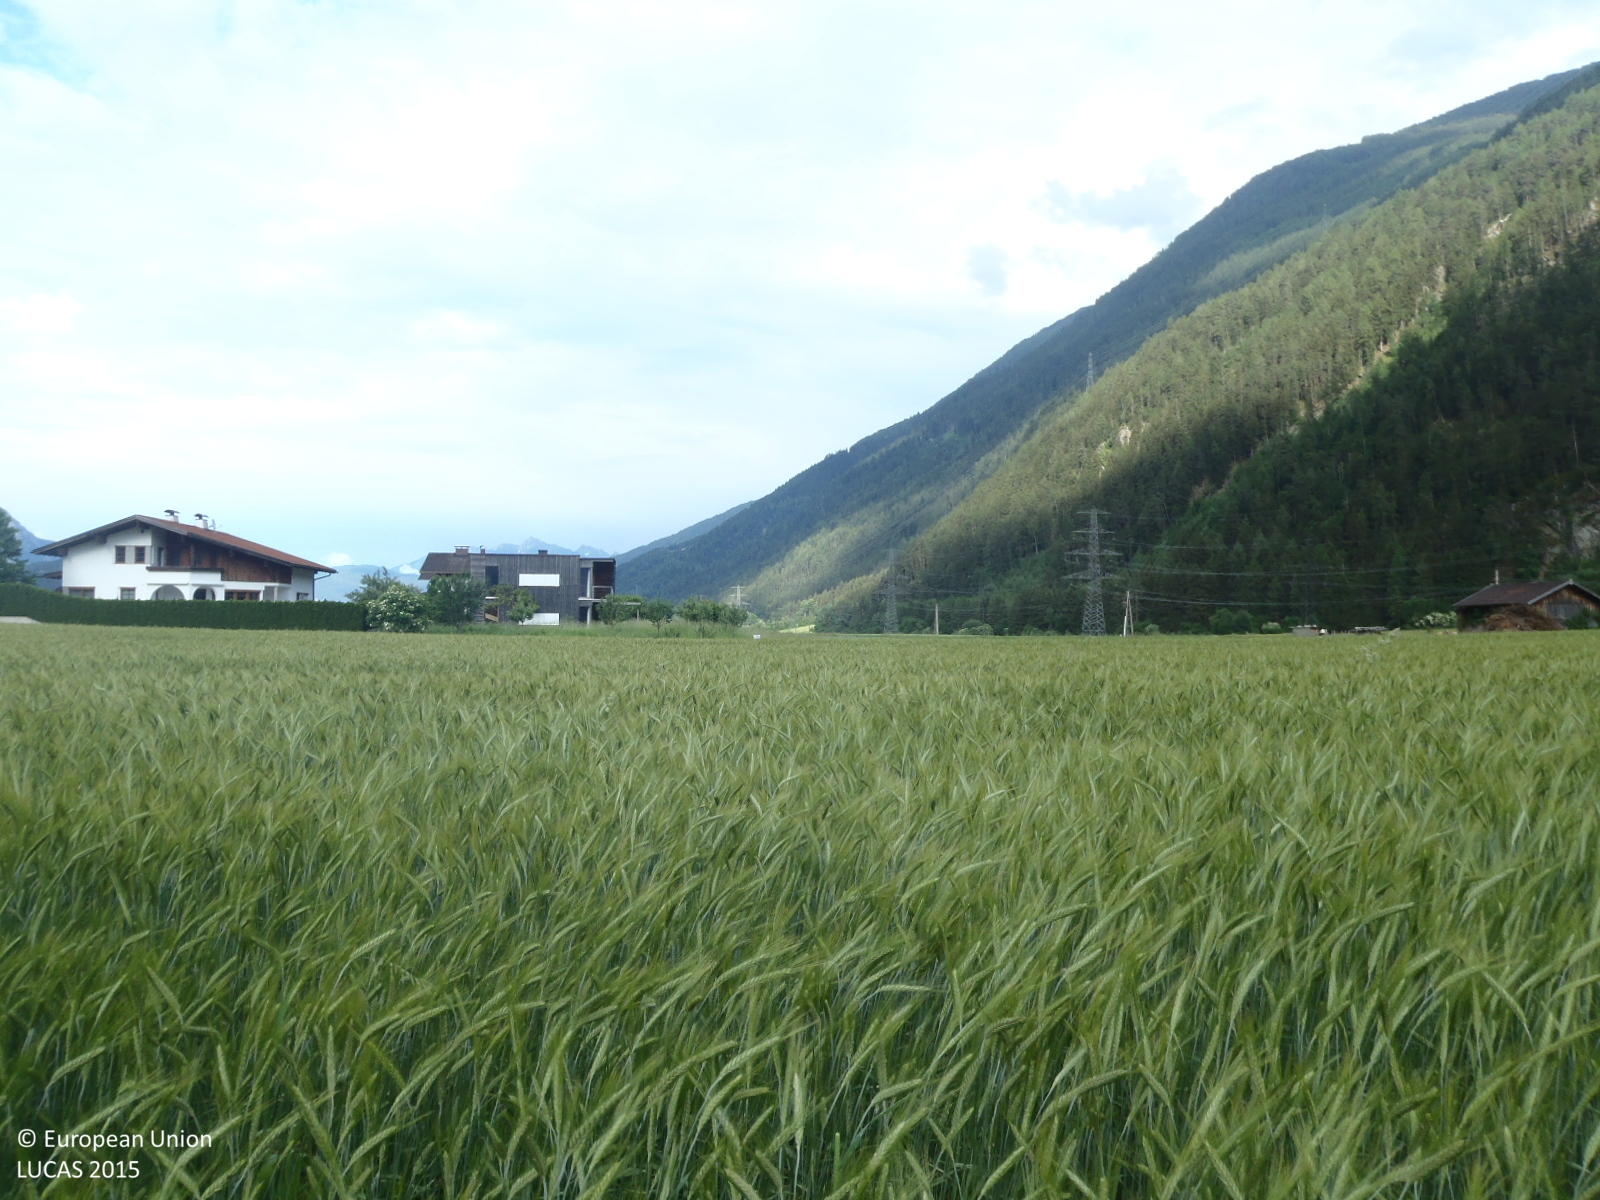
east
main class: Cropland
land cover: Rye
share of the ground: > 75 %
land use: Agriculture (excluding fallow land and kitchen gardens)
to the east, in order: Rye; Common wheat; Grass margins; Paved roads, cycling and walking lanes; Grass margins; Temporary grasslands; Maize; Temporary grasslands; Maize
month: June
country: AT
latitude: 47.2655
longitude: 10.9375
